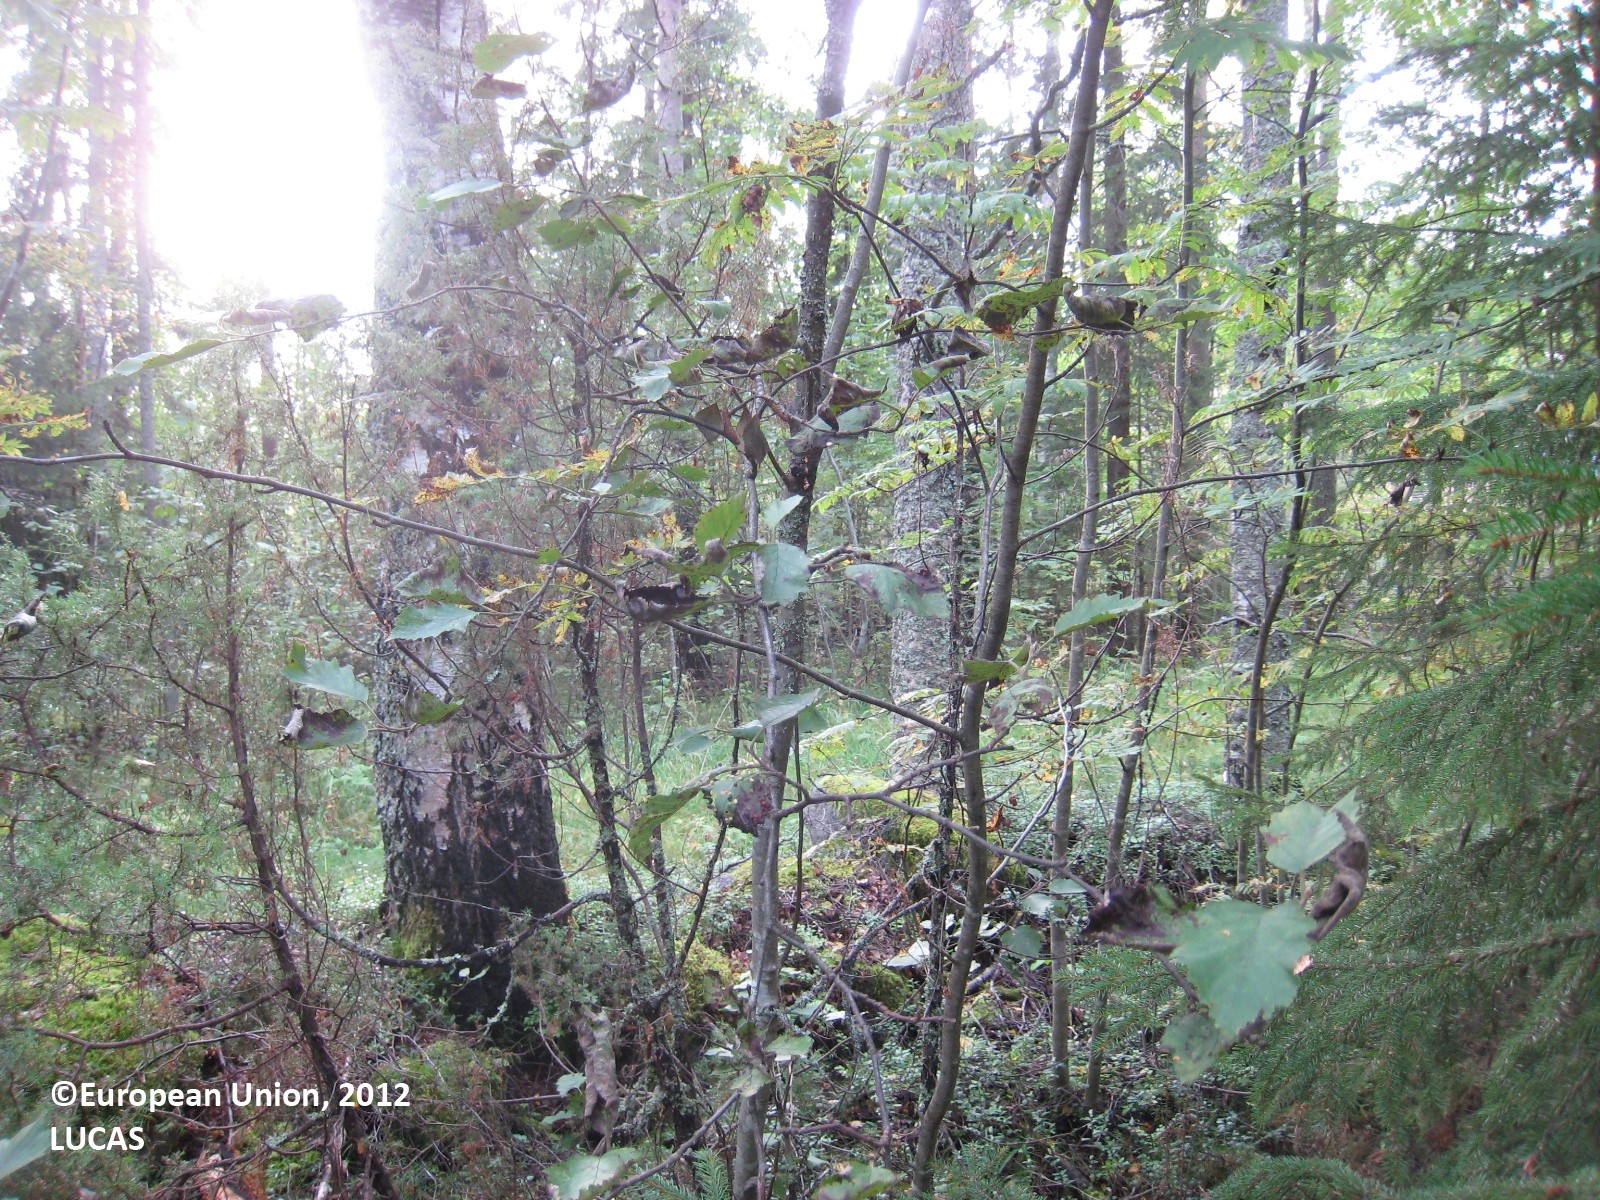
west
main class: Woodland
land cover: Spruce dominated mixed woodland
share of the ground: > 75 %
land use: Forestry
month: September
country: FI
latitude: 62.9541
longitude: 26.6361
